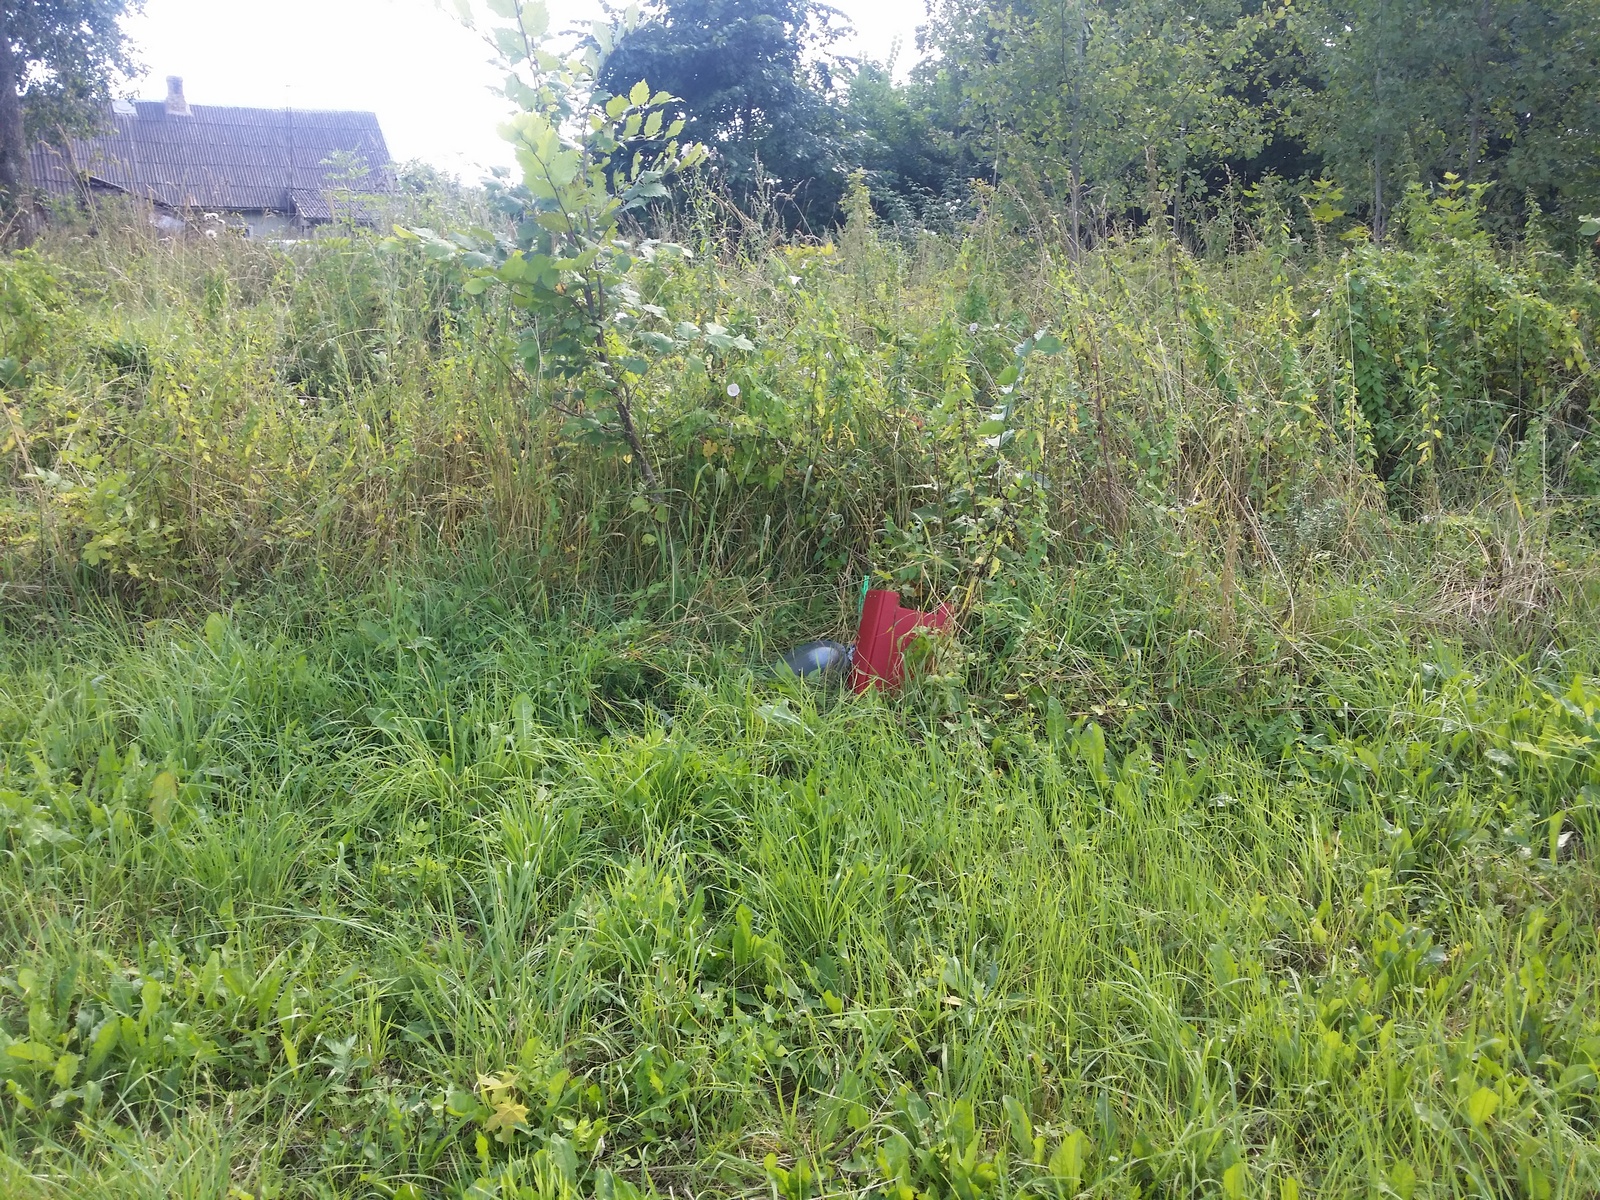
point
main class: Grassland
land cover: Grassland without tree/shrub cover
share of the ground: > 75 %
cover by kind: herbaceous plants 100 %
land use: Agriculture (excluding fallow land and kitchen gardens)
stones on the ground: < 10 %
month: August
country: LV
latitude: 56.9692
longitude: 27.5998
